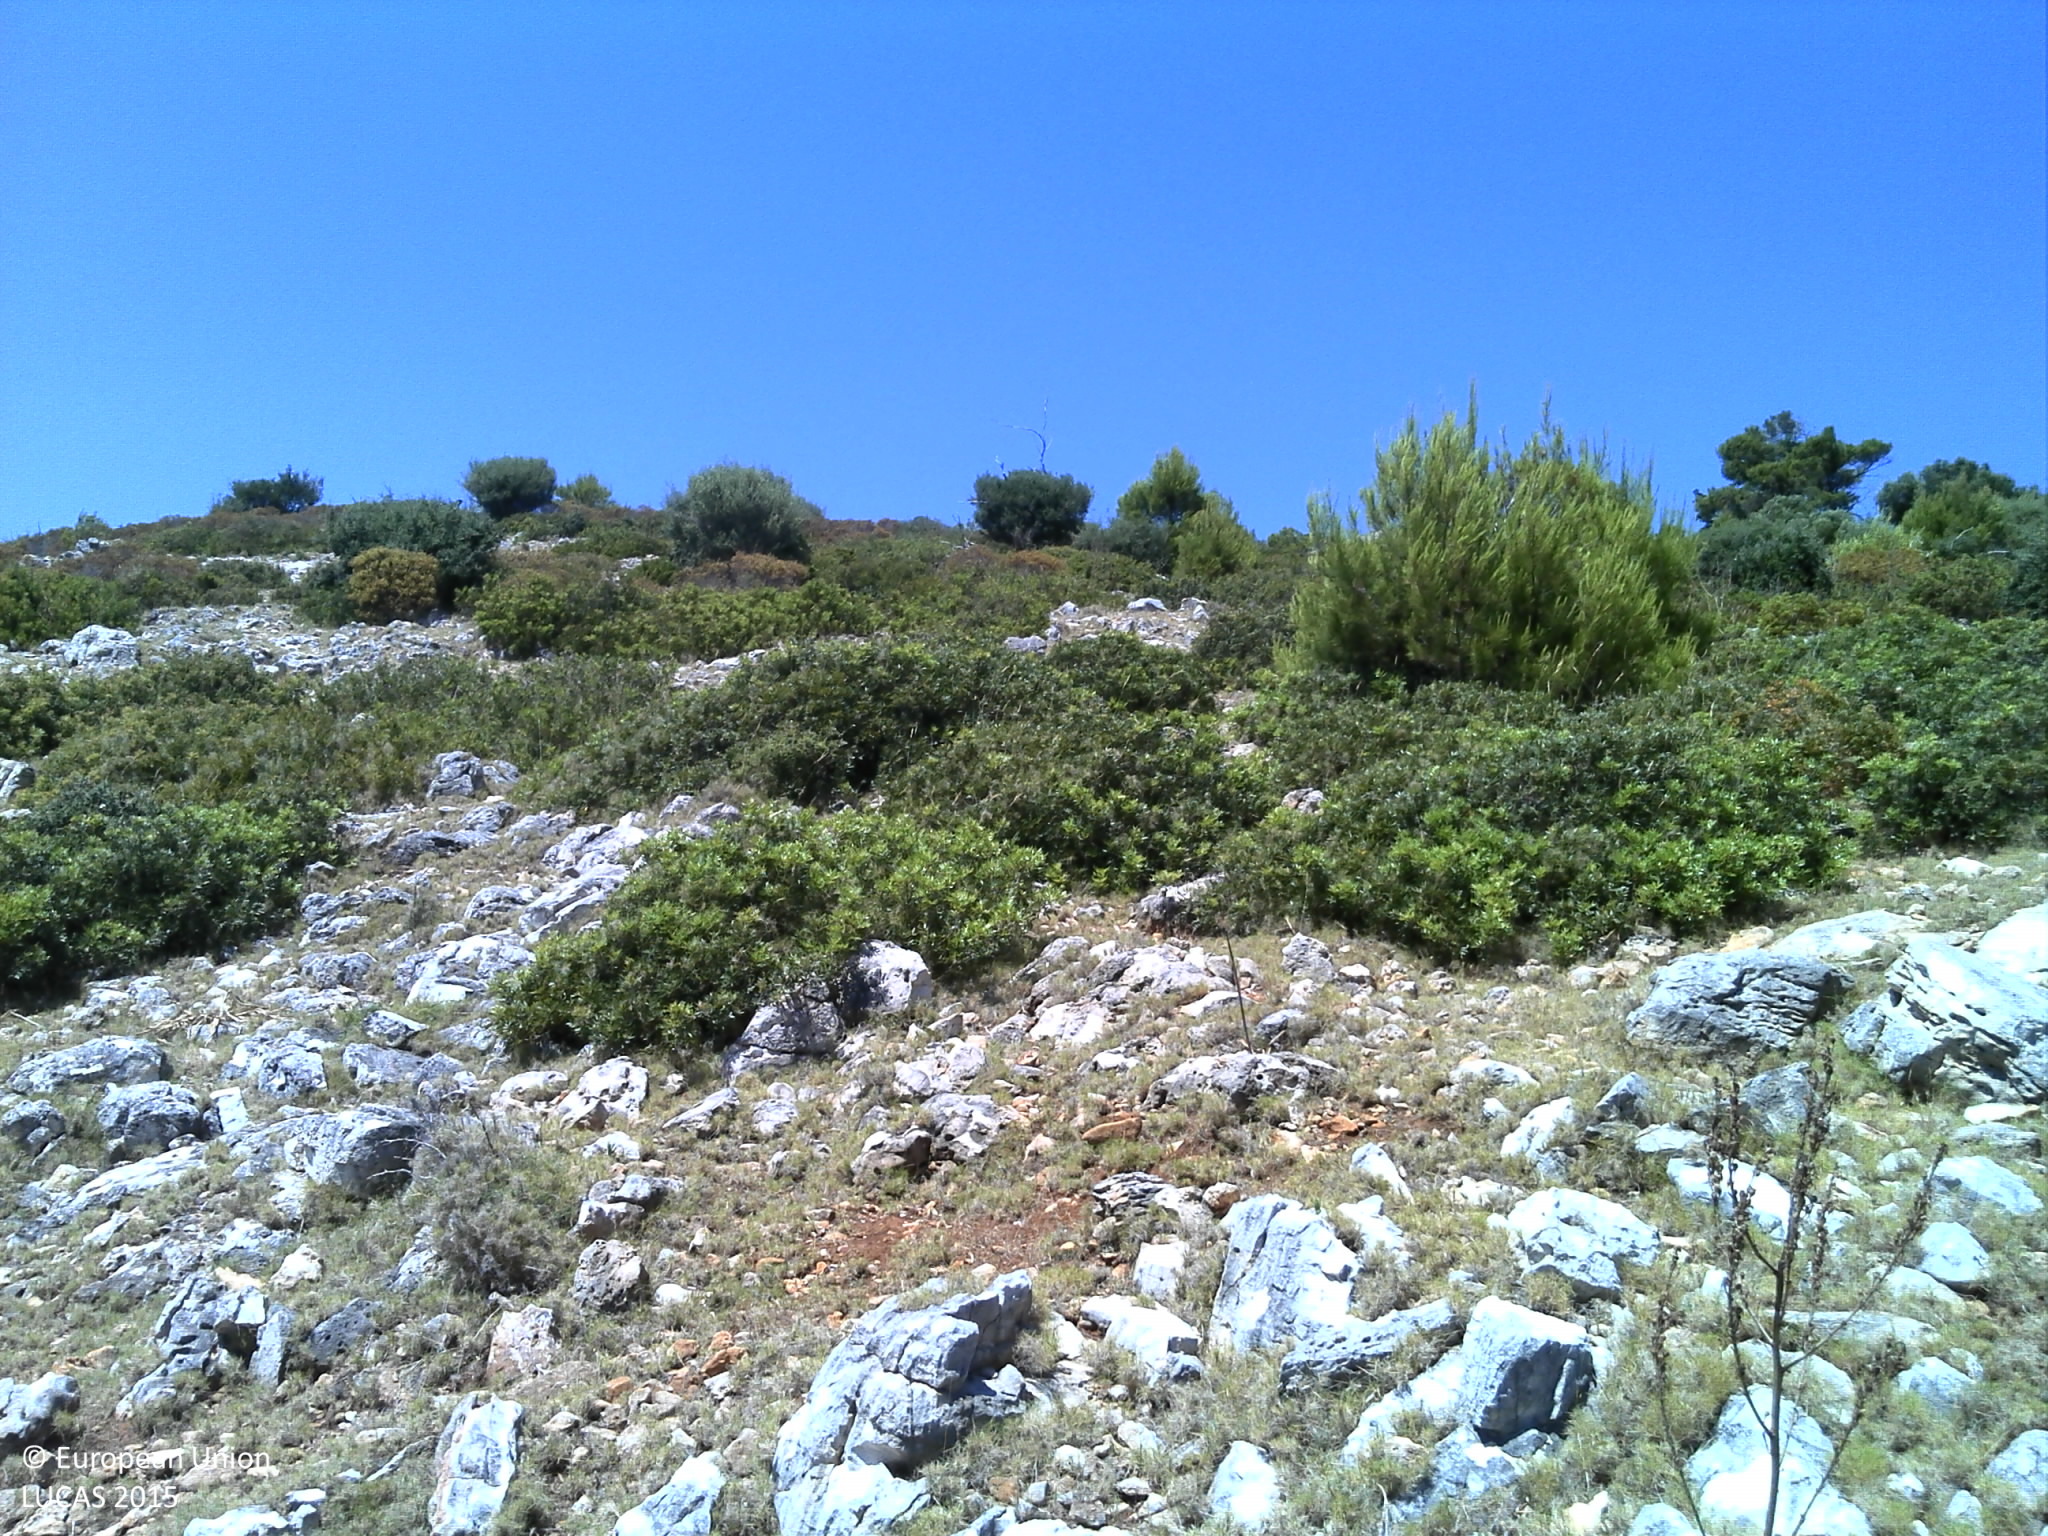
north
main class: Shrubland
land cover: Shrubland without tree cover
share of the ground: 50 - 75 %
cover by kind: shrubs 50 %, unconsolidated bare surface 25 %, consolidated bare surface 15 %, herbaceous plants 10 %
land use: Semi-natural and natural areas not in use
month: June
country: HR
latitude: 42.7307
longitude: 16.8396
